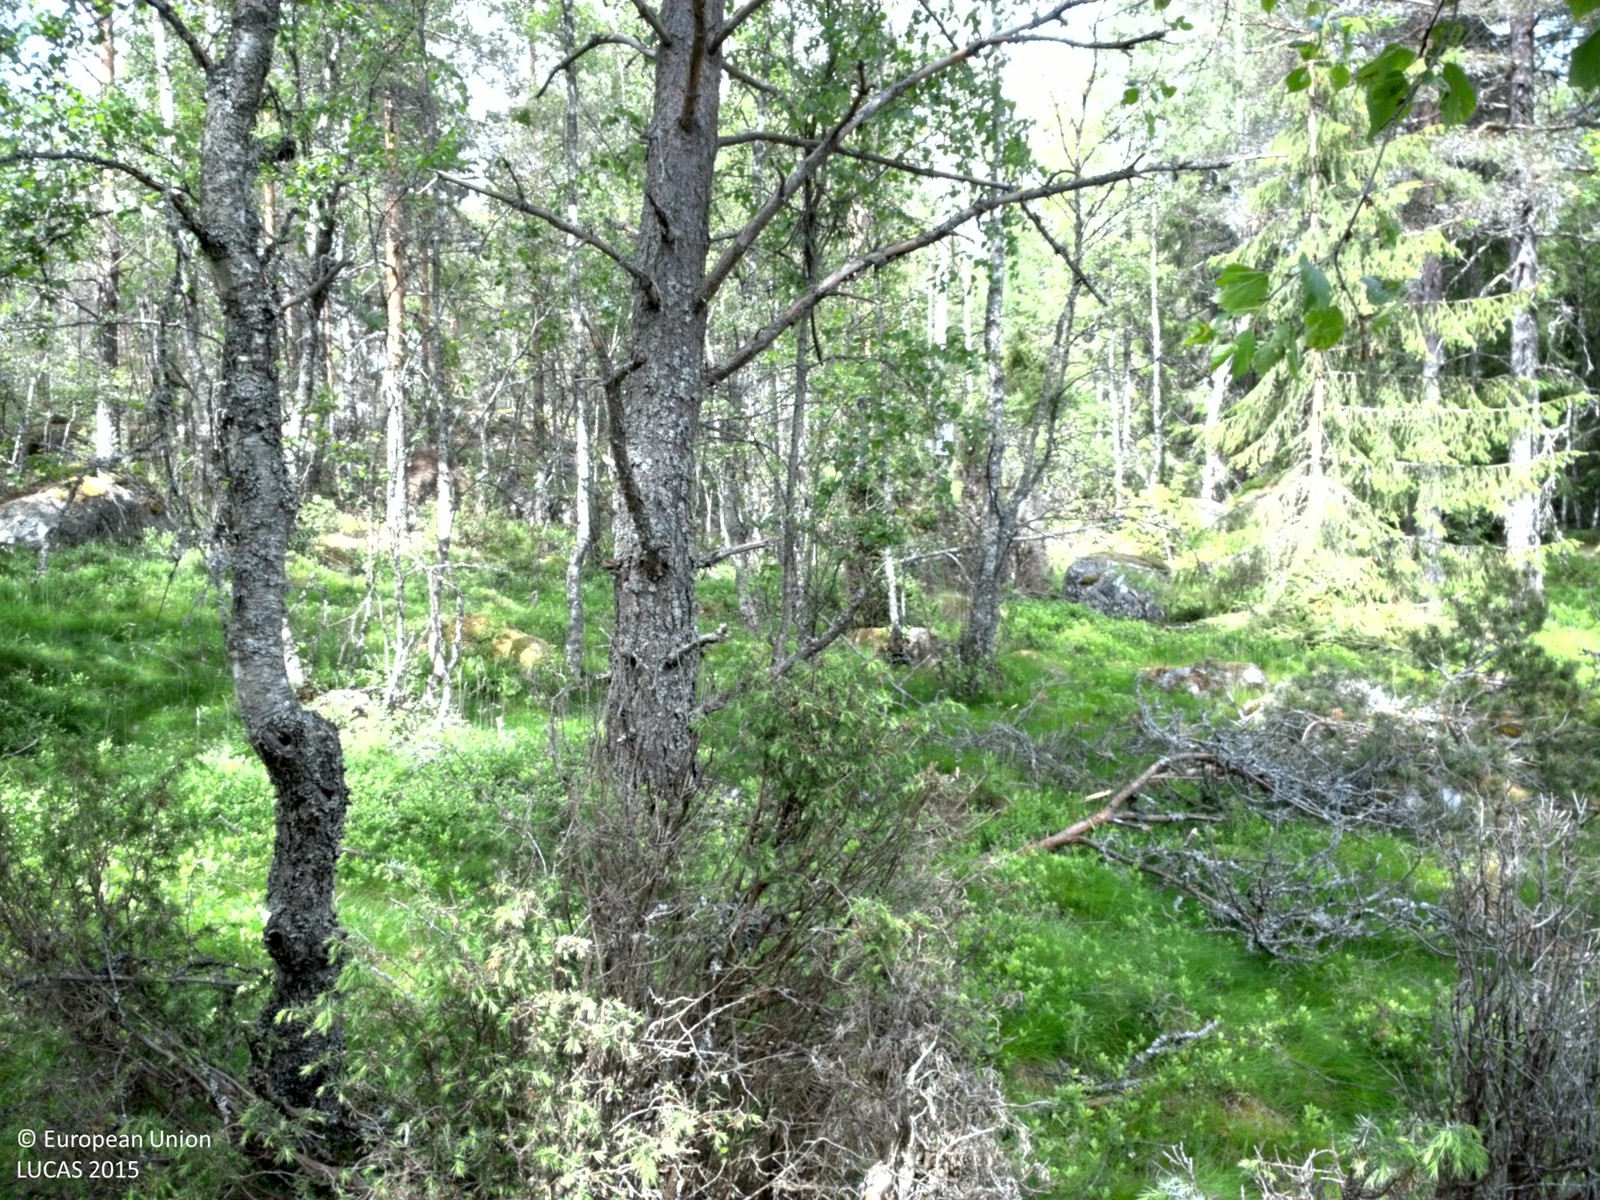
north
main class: Woodland
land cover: Broadleaved woodland
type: hemiboreal forest and nemoral coniferous forest and mixed broadleaved-coniferous forest
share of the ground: > 75 %
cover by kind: broadleaved forest trees 65 %, herbaceous plants 25 %, coniferous forest trees 10 %
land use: Forestry
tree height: > 5 m
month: June
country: SE
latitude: 59.9816
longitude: 17.1423
